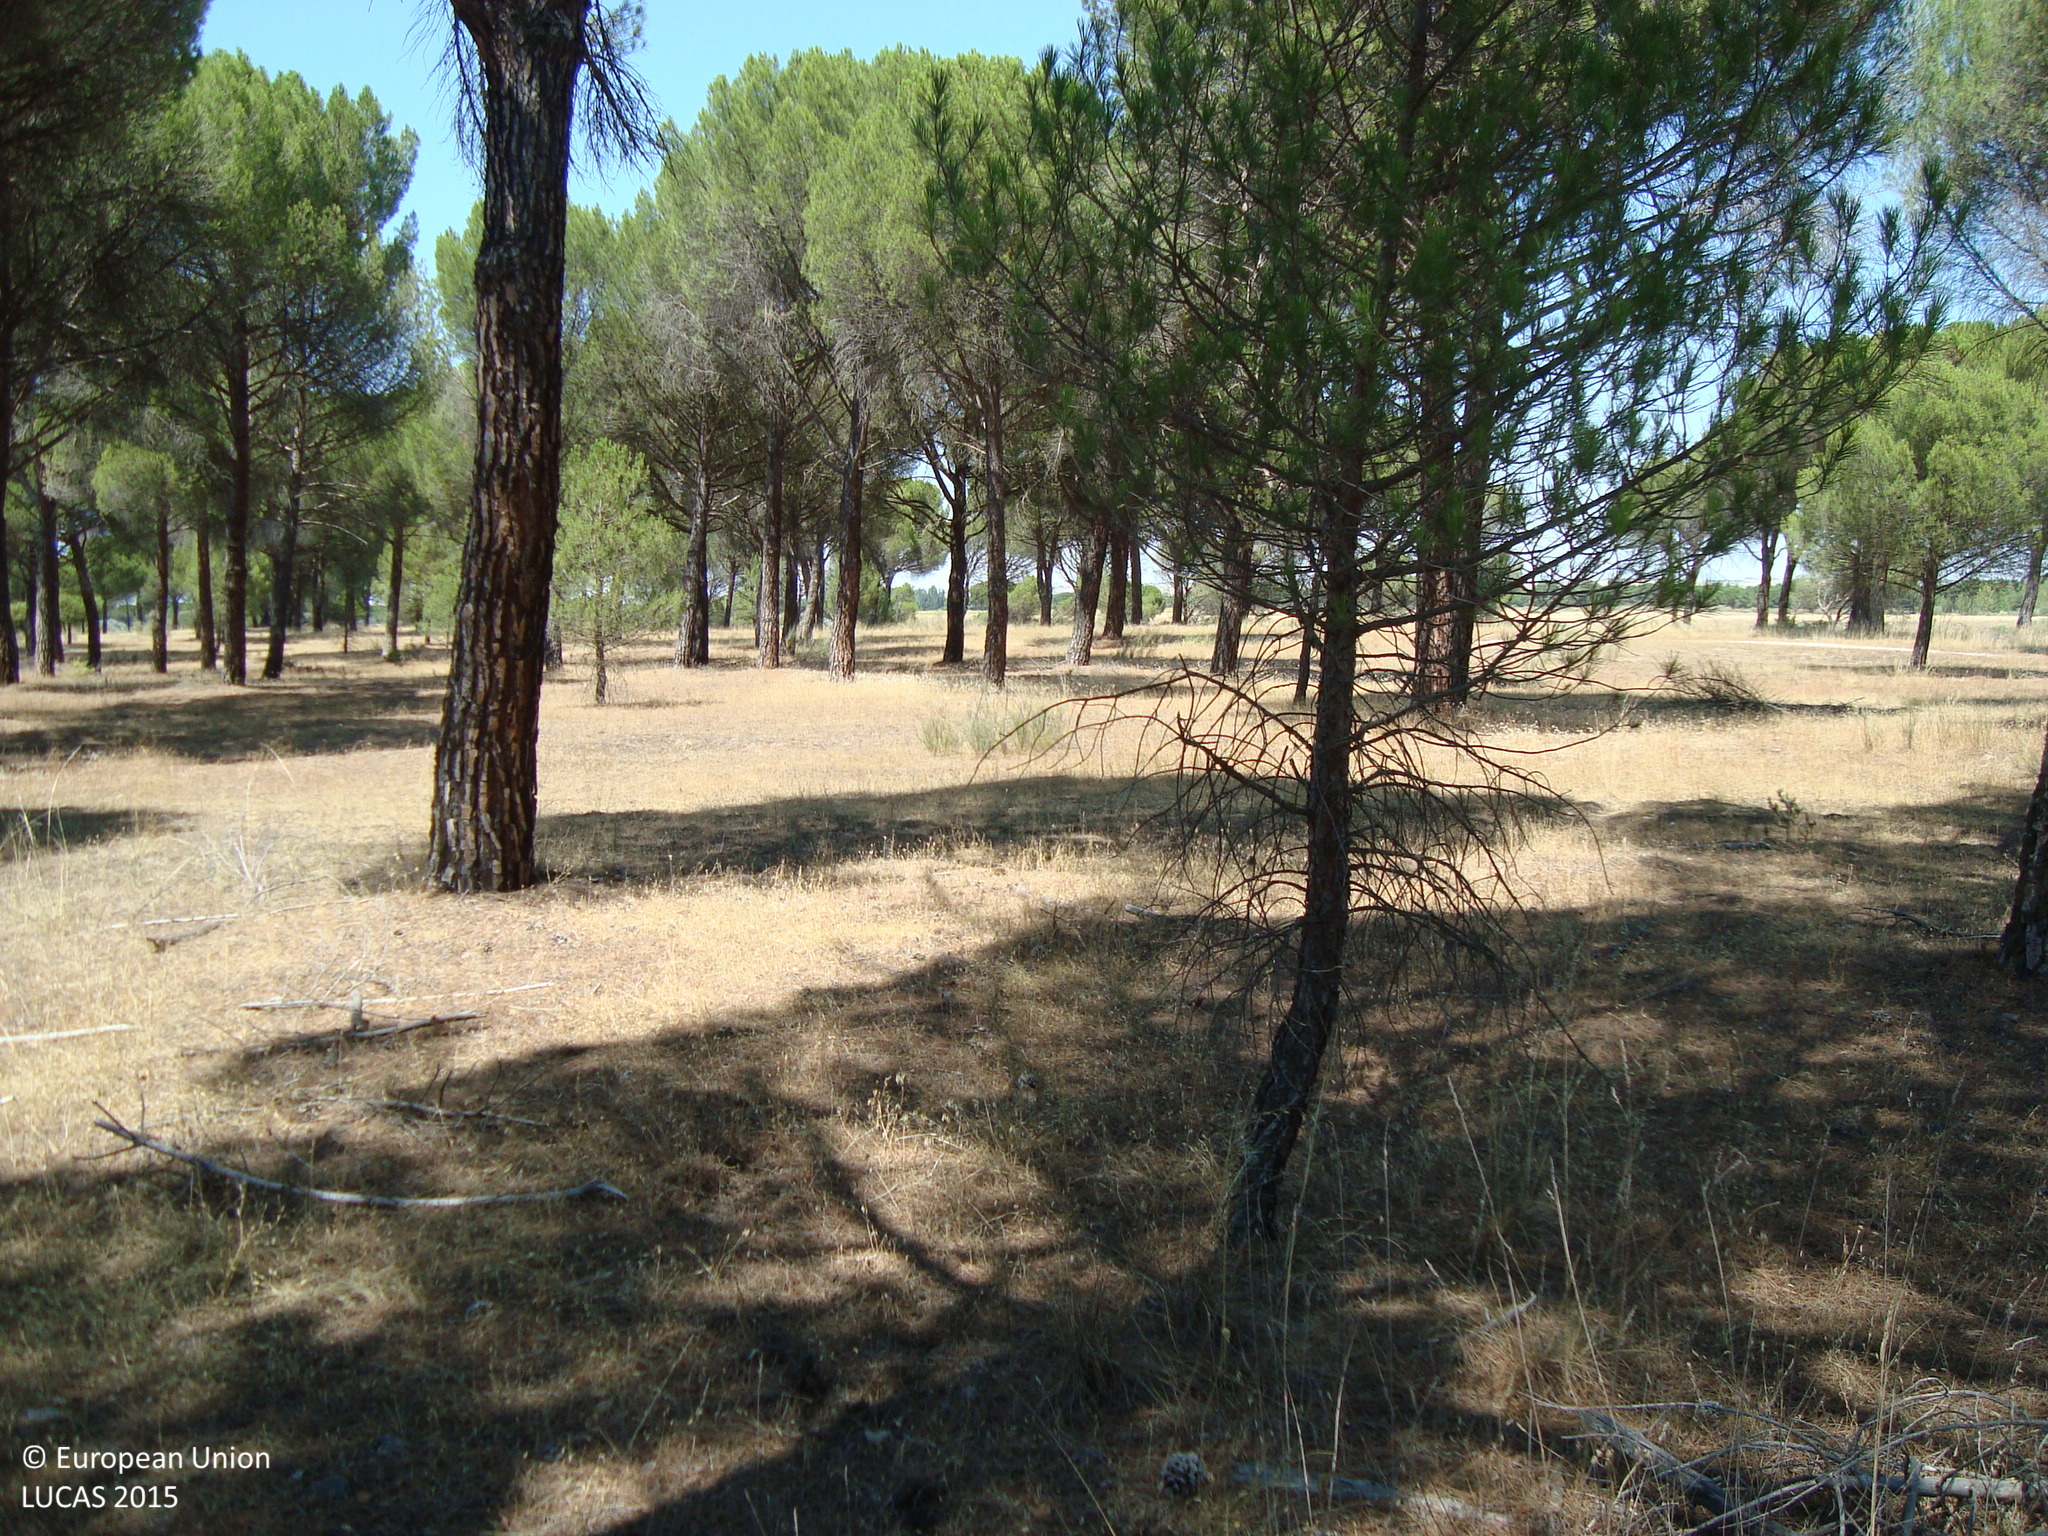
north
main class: Woodland
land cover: Pine dominated coniferous woodland
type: coniferous forest of the mediterranean region
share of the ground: 50 - 75 %
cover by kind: coniferous forest trees 60 %, herbaceous plants 30 %, shrubs 5 %, unconsolidated bare surface 5 %
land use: Forestry
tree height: > 5 m
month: August
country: ES
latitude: 41.2969
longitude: -4.5961
